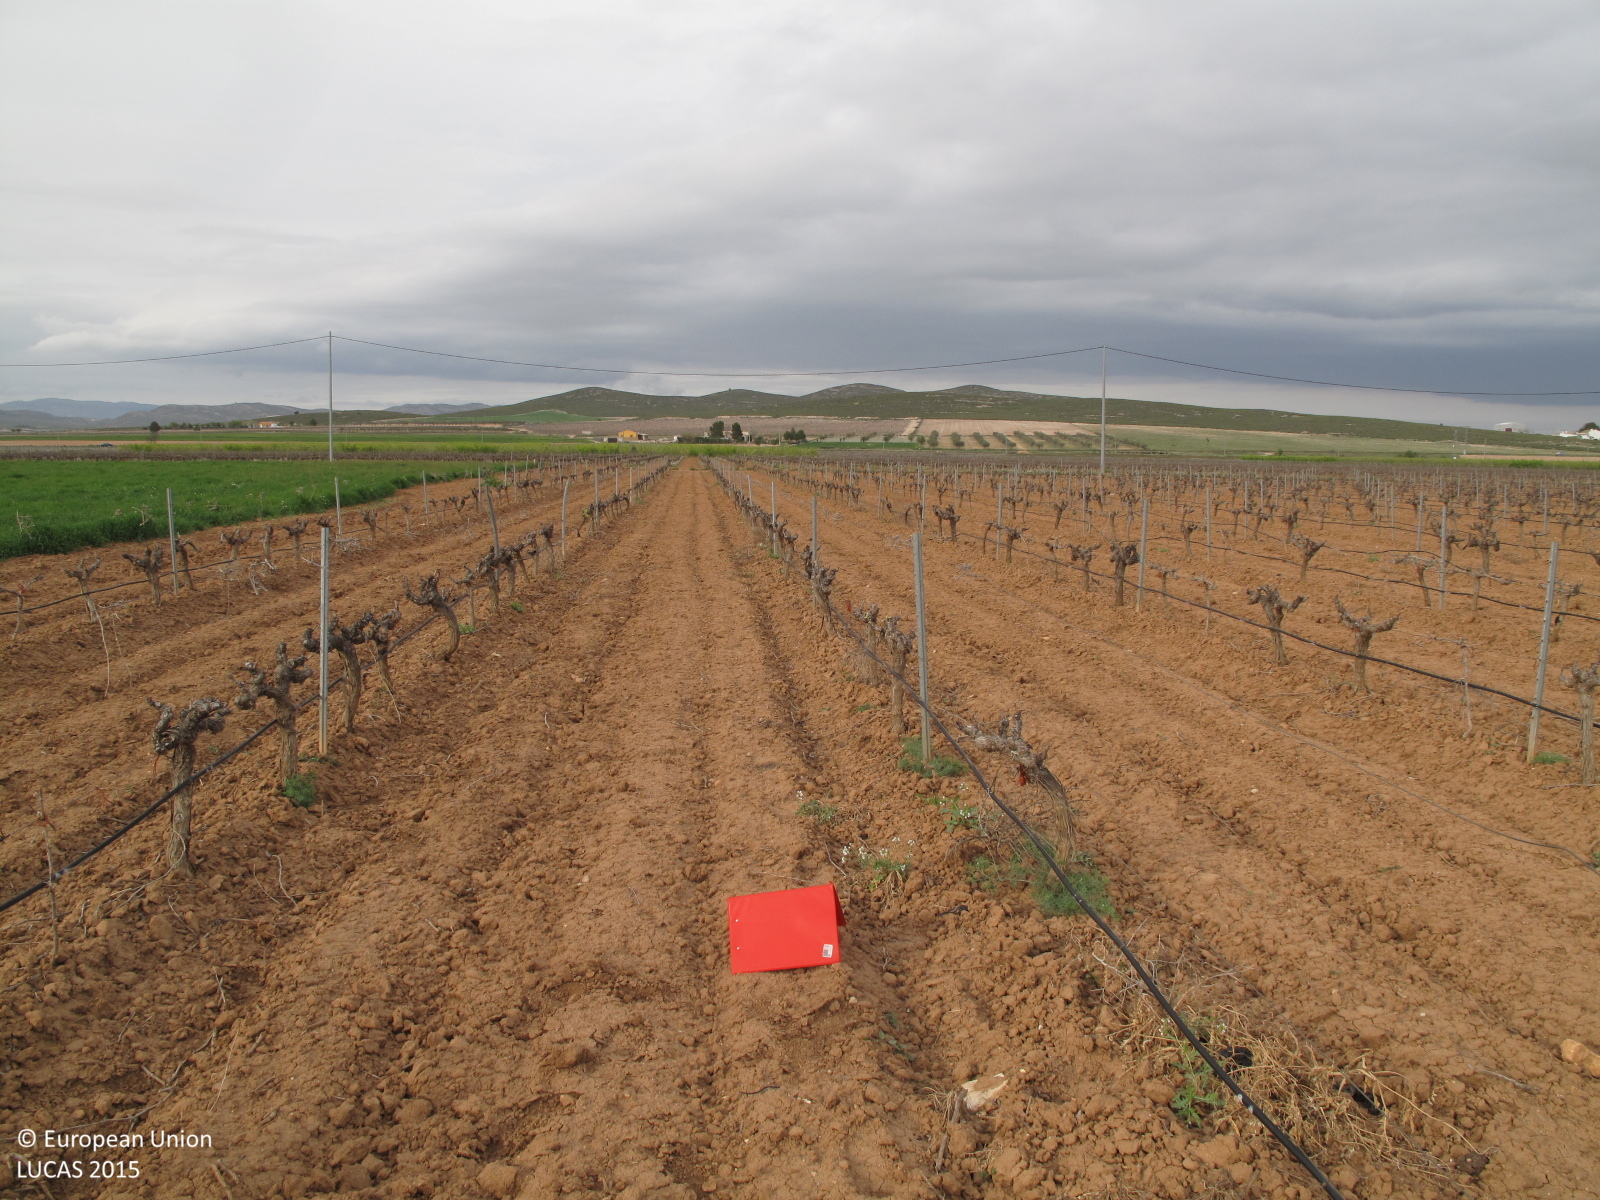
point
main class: Cropland
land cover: Vineyards
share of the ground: < 10 %
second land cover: Other bare soil
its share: > 75 %
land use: Agriculture (excluding fallow land and kitchen gardens)
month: April
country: ES
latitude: 38.5827
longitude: -1.0453
